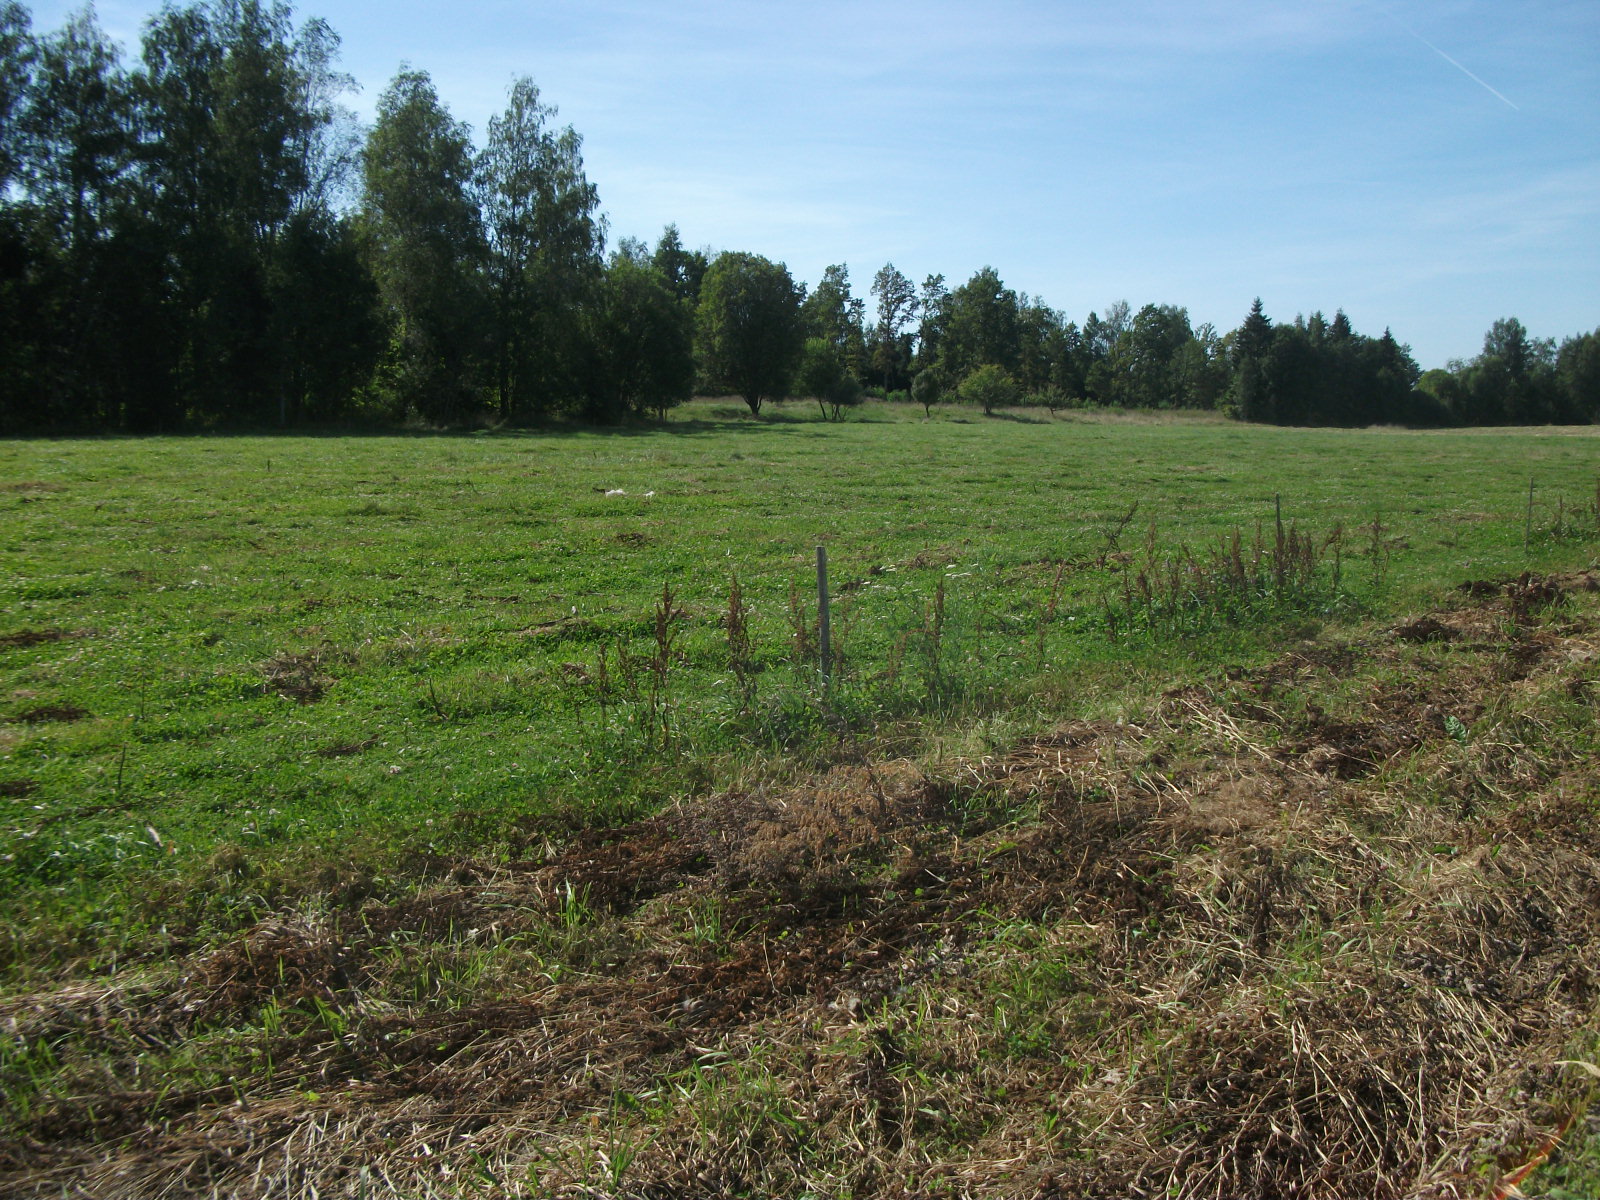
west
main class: Cropland
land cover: Potatoes
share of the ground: < 10 %
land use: Agriculture (excluding fallow land and kitchen gardens)
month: August
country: LV
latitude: 56.2043
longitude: 26.2789
